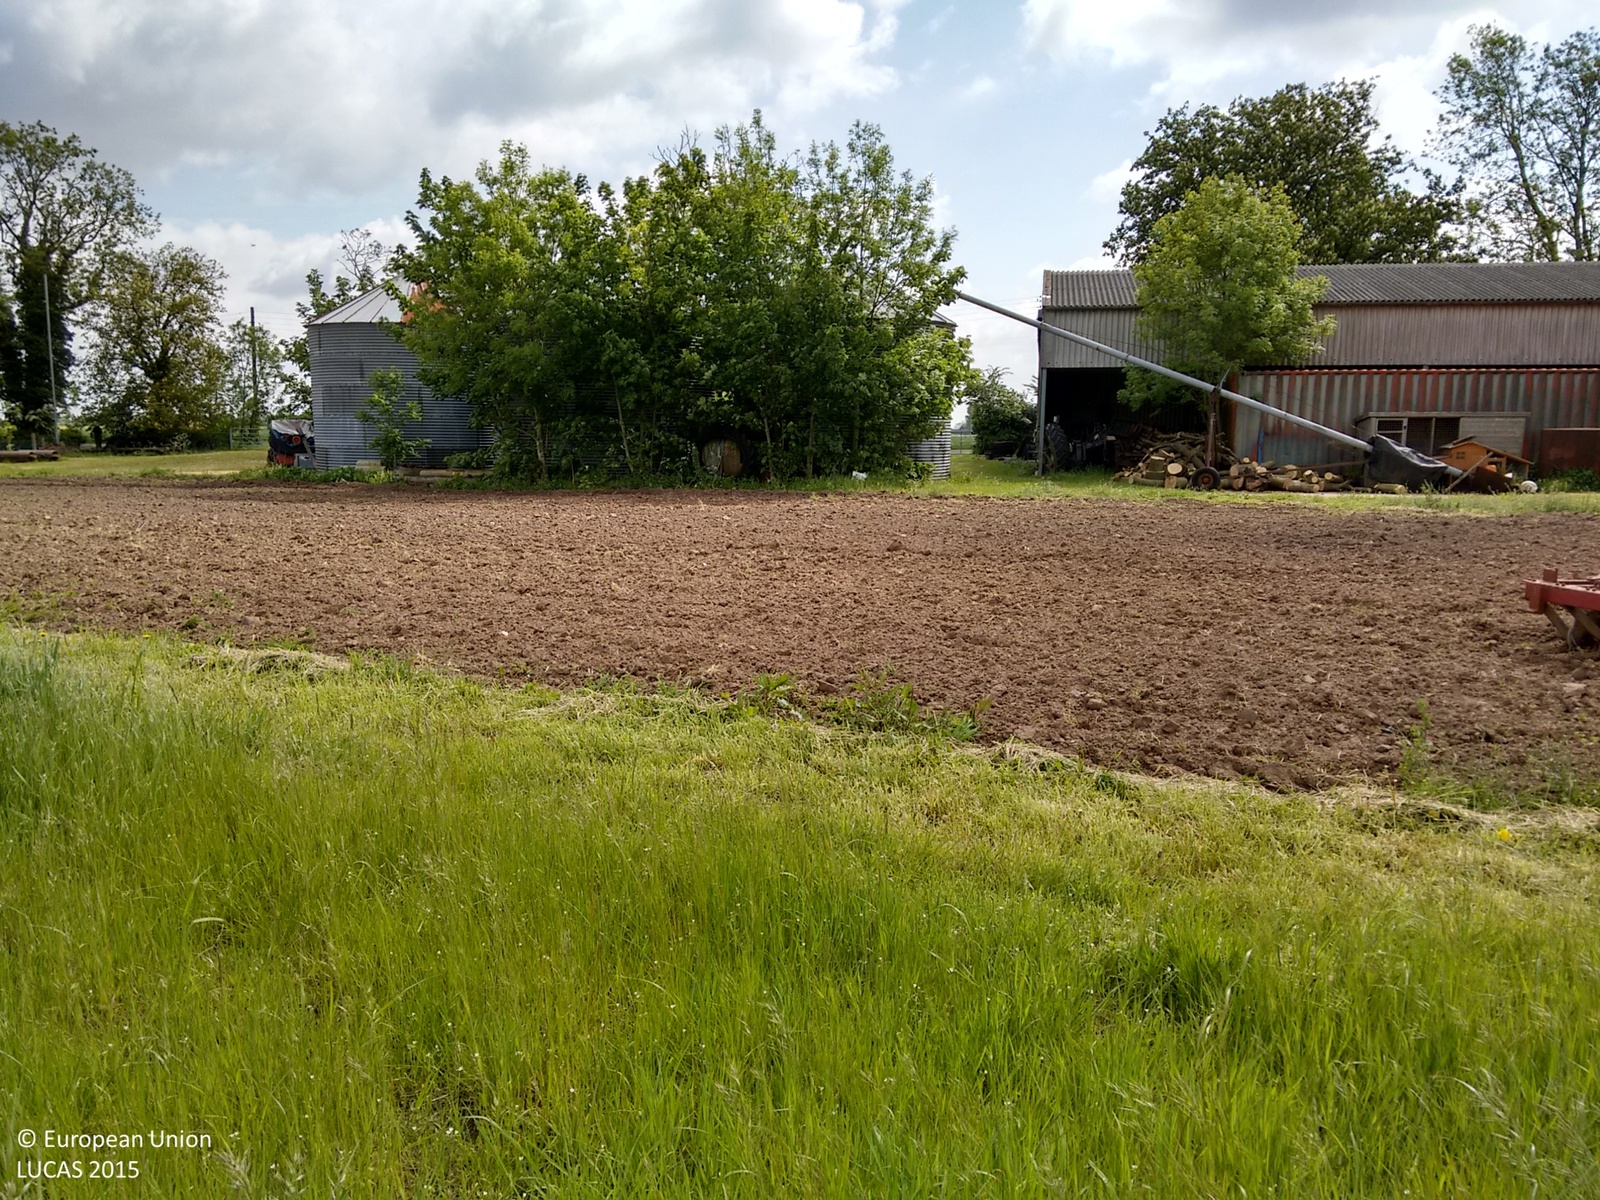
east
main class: Grassland
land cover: Grassland without tree/shrub cover
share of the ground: > 75 %
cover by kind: herbaceous plants 100 %
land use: Agriculture (excluding fallow land and kitchen gardens)
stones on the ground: < 10 %
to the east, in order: Grassland without tree/shrub cover; Other bare soil; Artificial constructions in urban areas; Grass margins; Common wheat
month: May
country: GB
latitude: 52.7512
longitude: -0.0032
